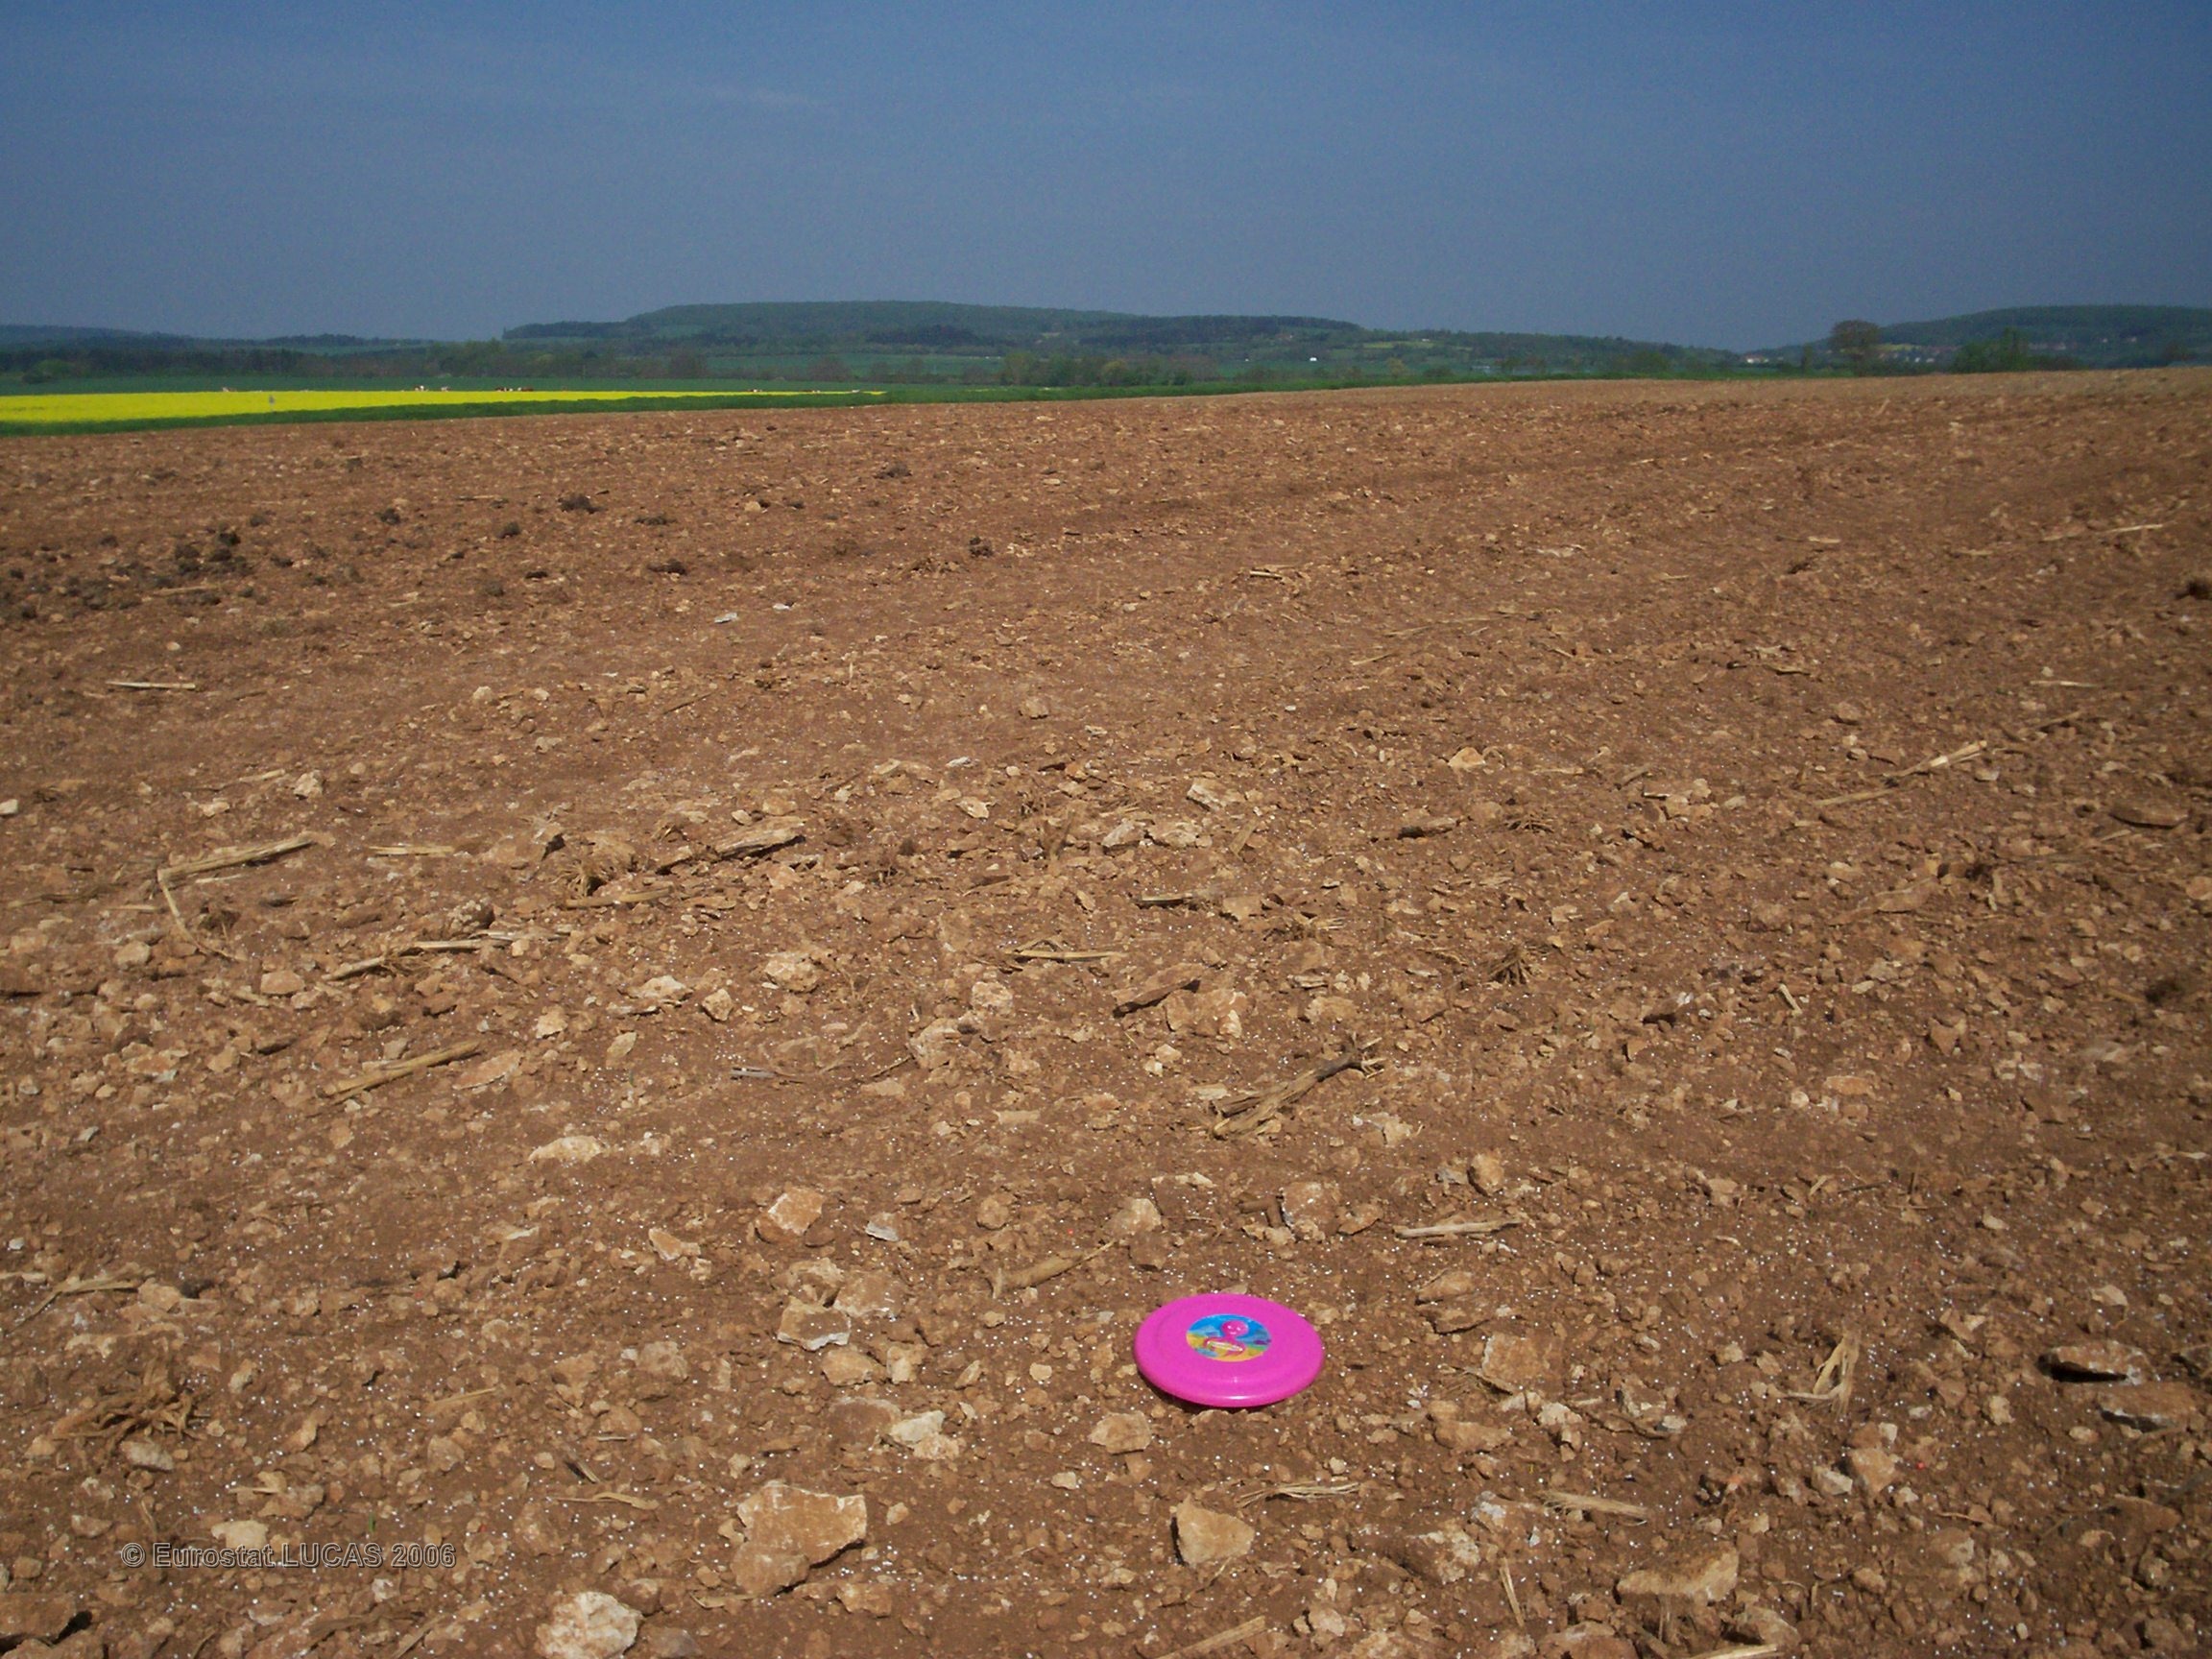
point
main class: Cropland
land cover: Maize
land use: Agriculture (excluding fallow land and kitchen gardens)
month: May
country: FR
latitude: 47.6367
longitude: 5.3020
